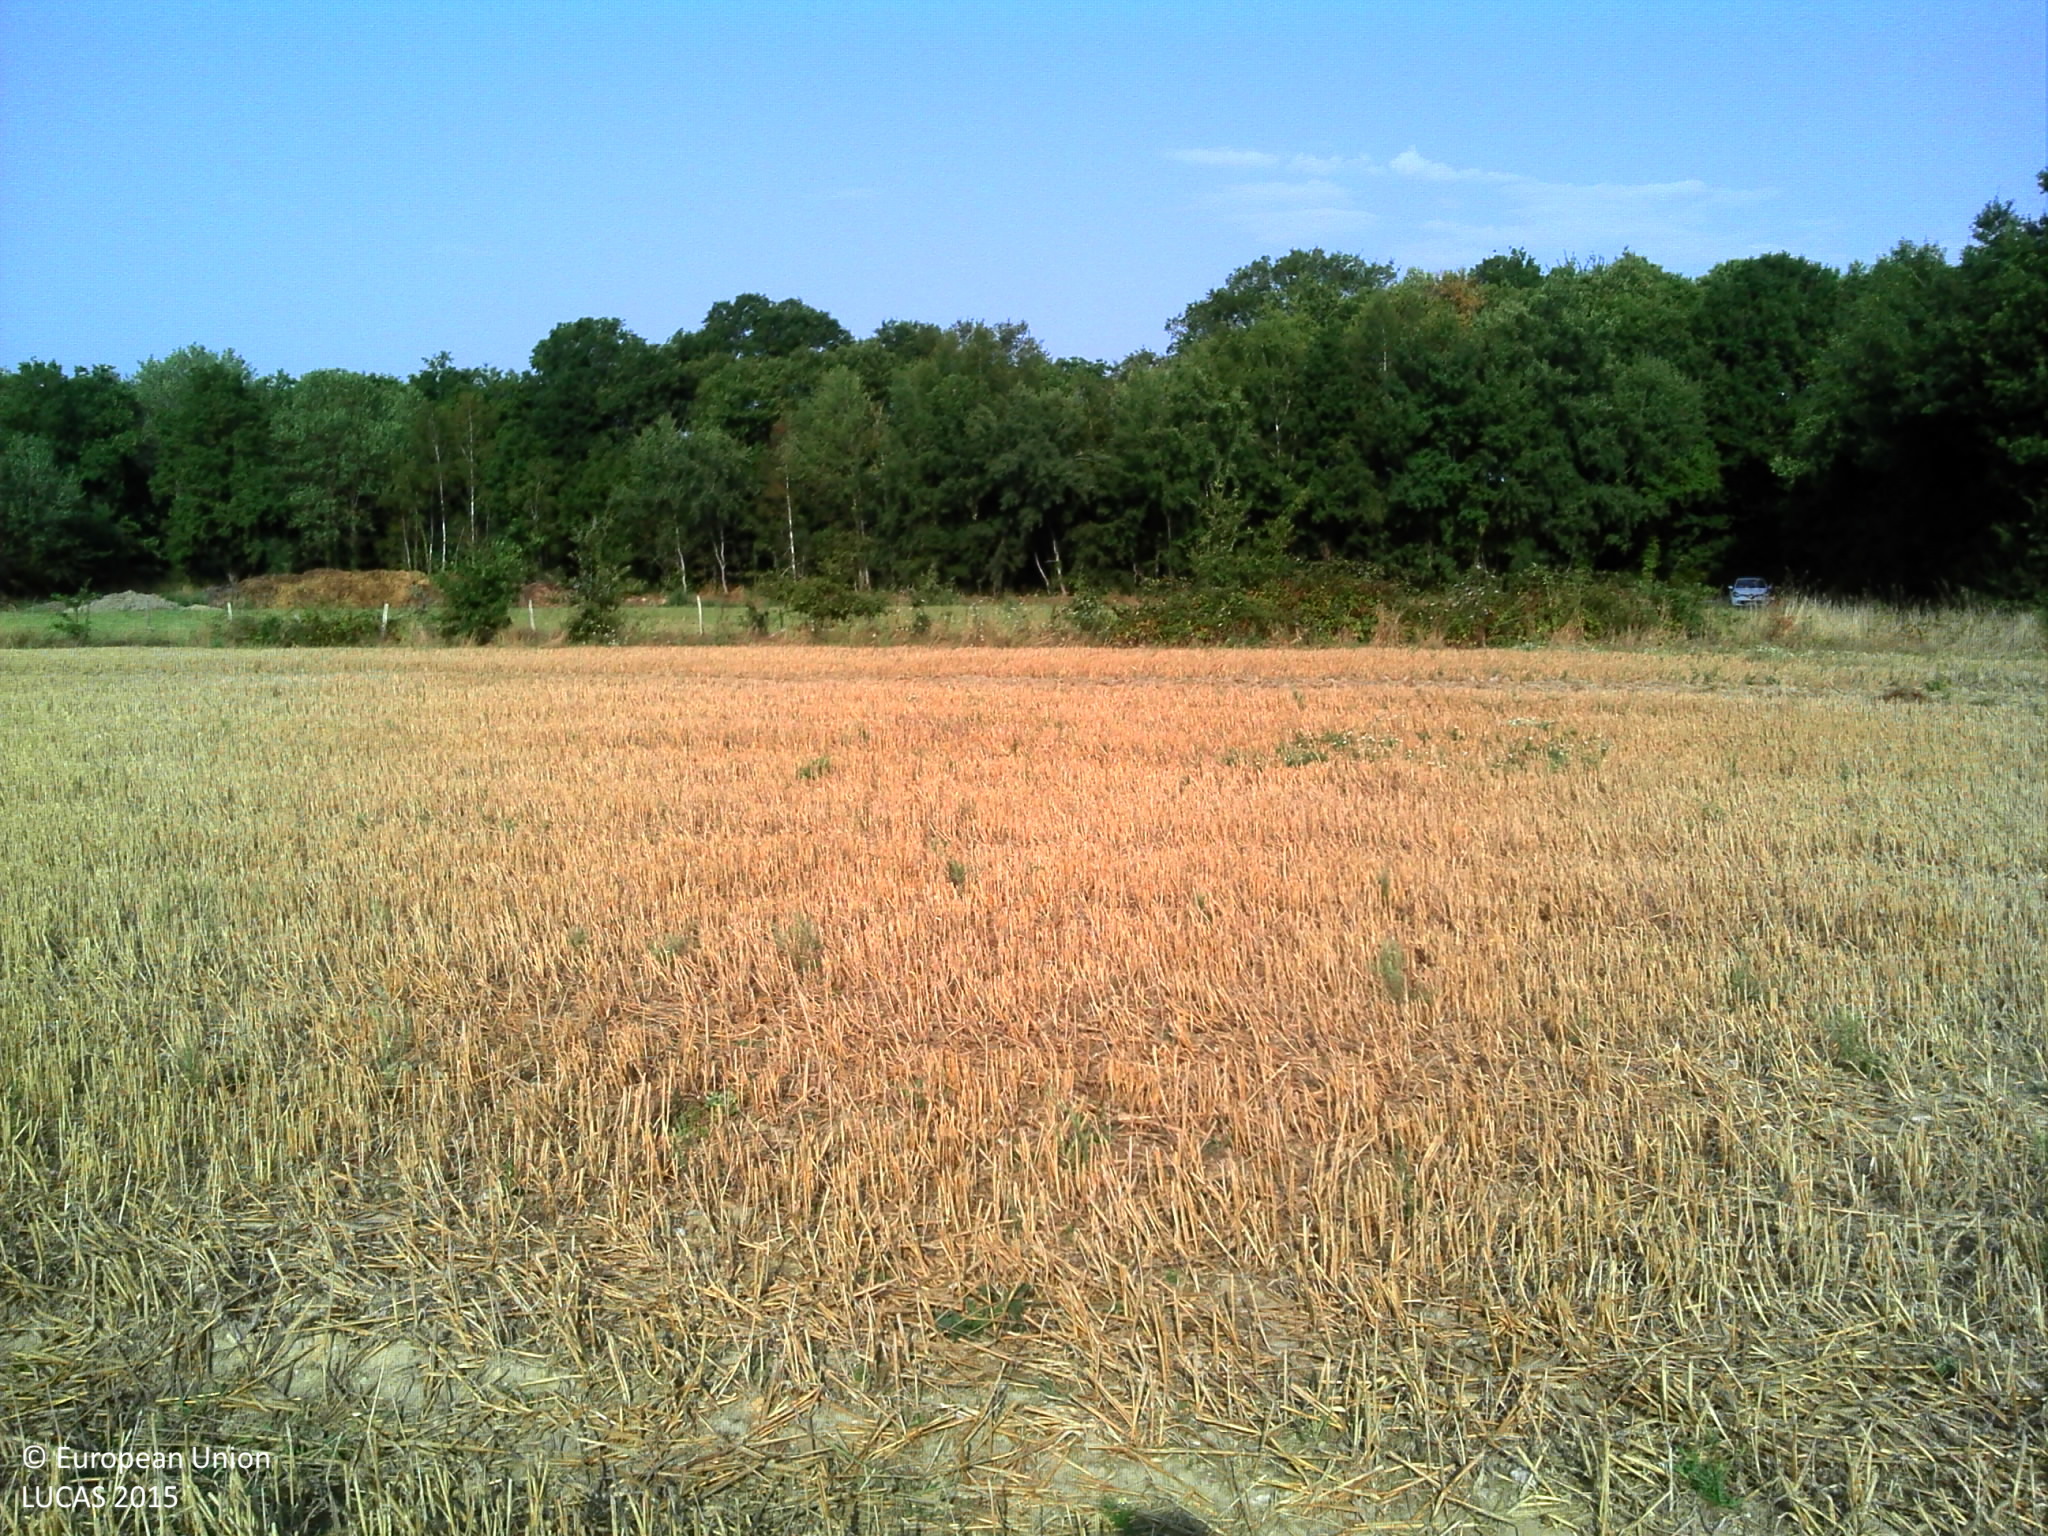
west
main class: Cropland
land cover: Triticale
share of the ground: > 75 %
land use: Agriculture (excluding fallow land and kitchen gardens)
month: August
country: FR
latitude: 46.9468
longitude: -1.6695
